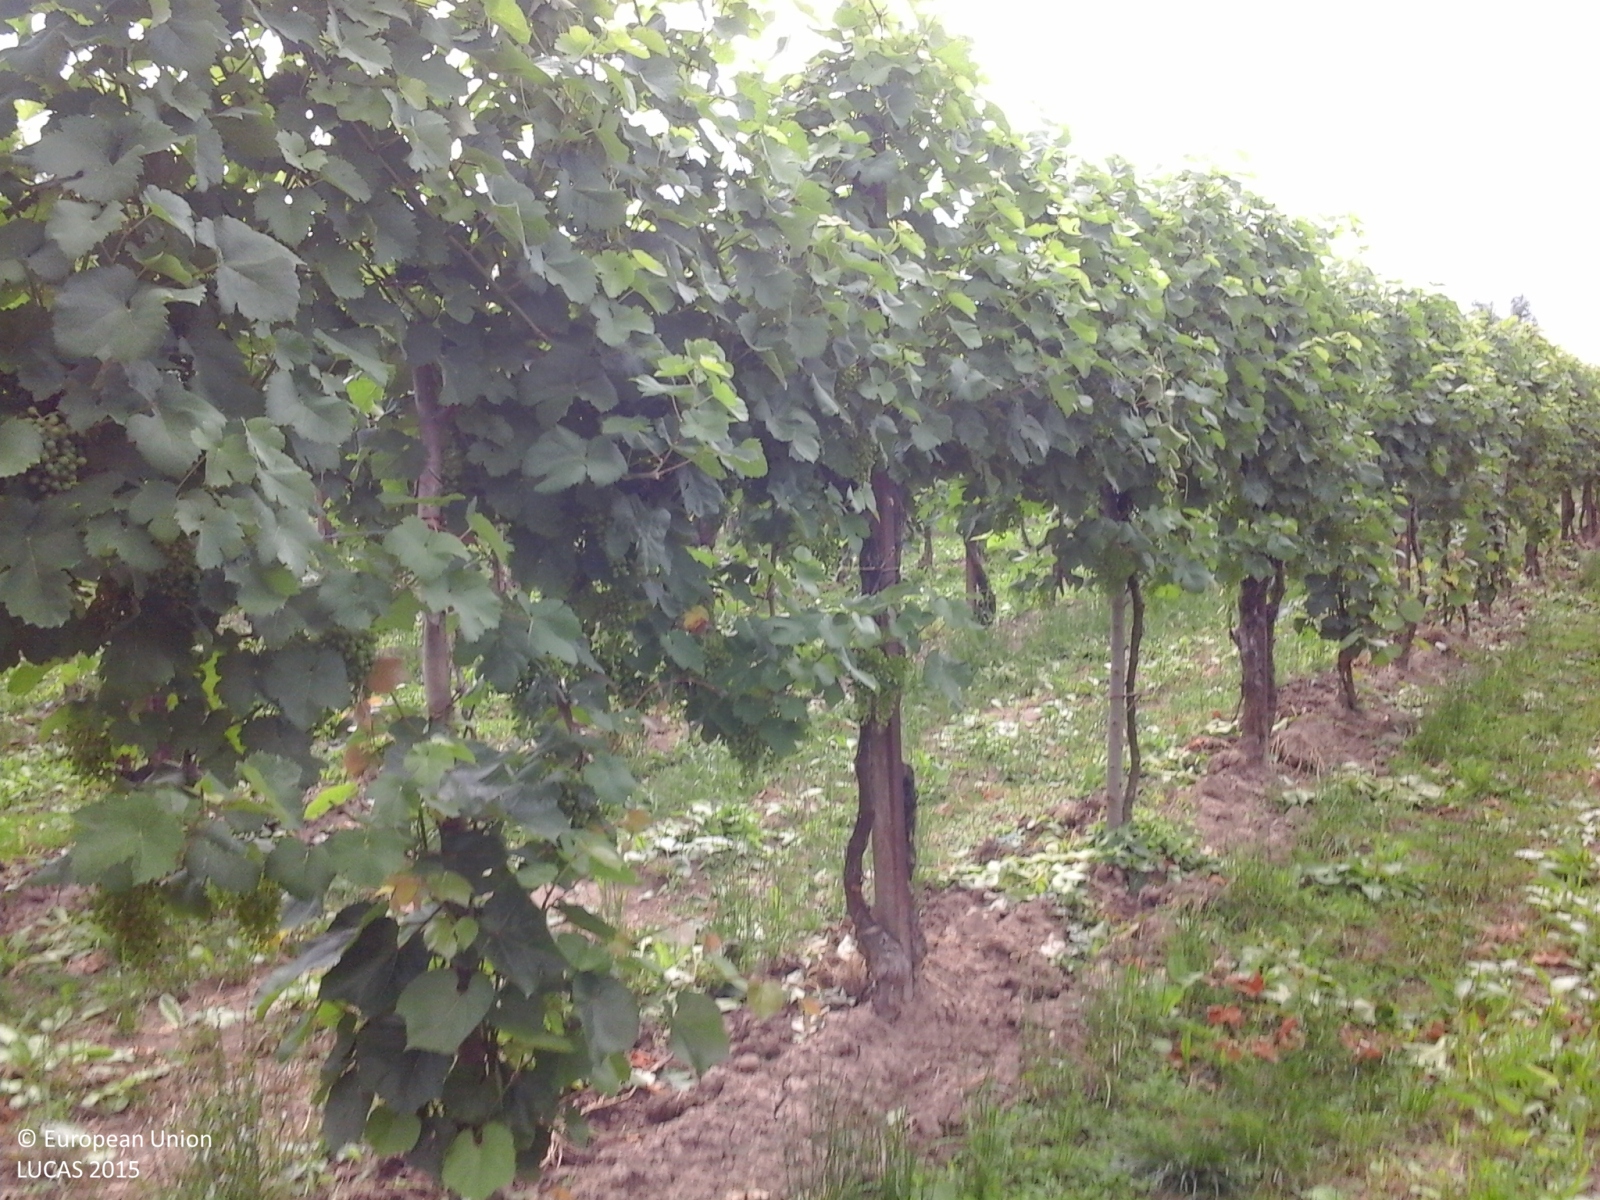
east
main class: Cropland
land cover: Vineyards
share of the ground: 25 - 50 %
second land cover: Grassland without tree/shrub cover
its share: > 75 %
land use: Agriculture (excluding fallow land and kitchen gardens)
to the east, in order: Vineyards; Grassland without tree/shrub cover; Artificial constructions in urban areas; Ditches and canals; Electric lines; Paved roads, cycling and walking lanes; Ditches and canals; Grassland without tree/shrub cover; Soya; Electric lines; Soya; Grass margins; Ditches and canals; Vineyards; Tracks; Vineyards
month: June
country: IT
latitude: 45.6906
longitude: 12.5261
